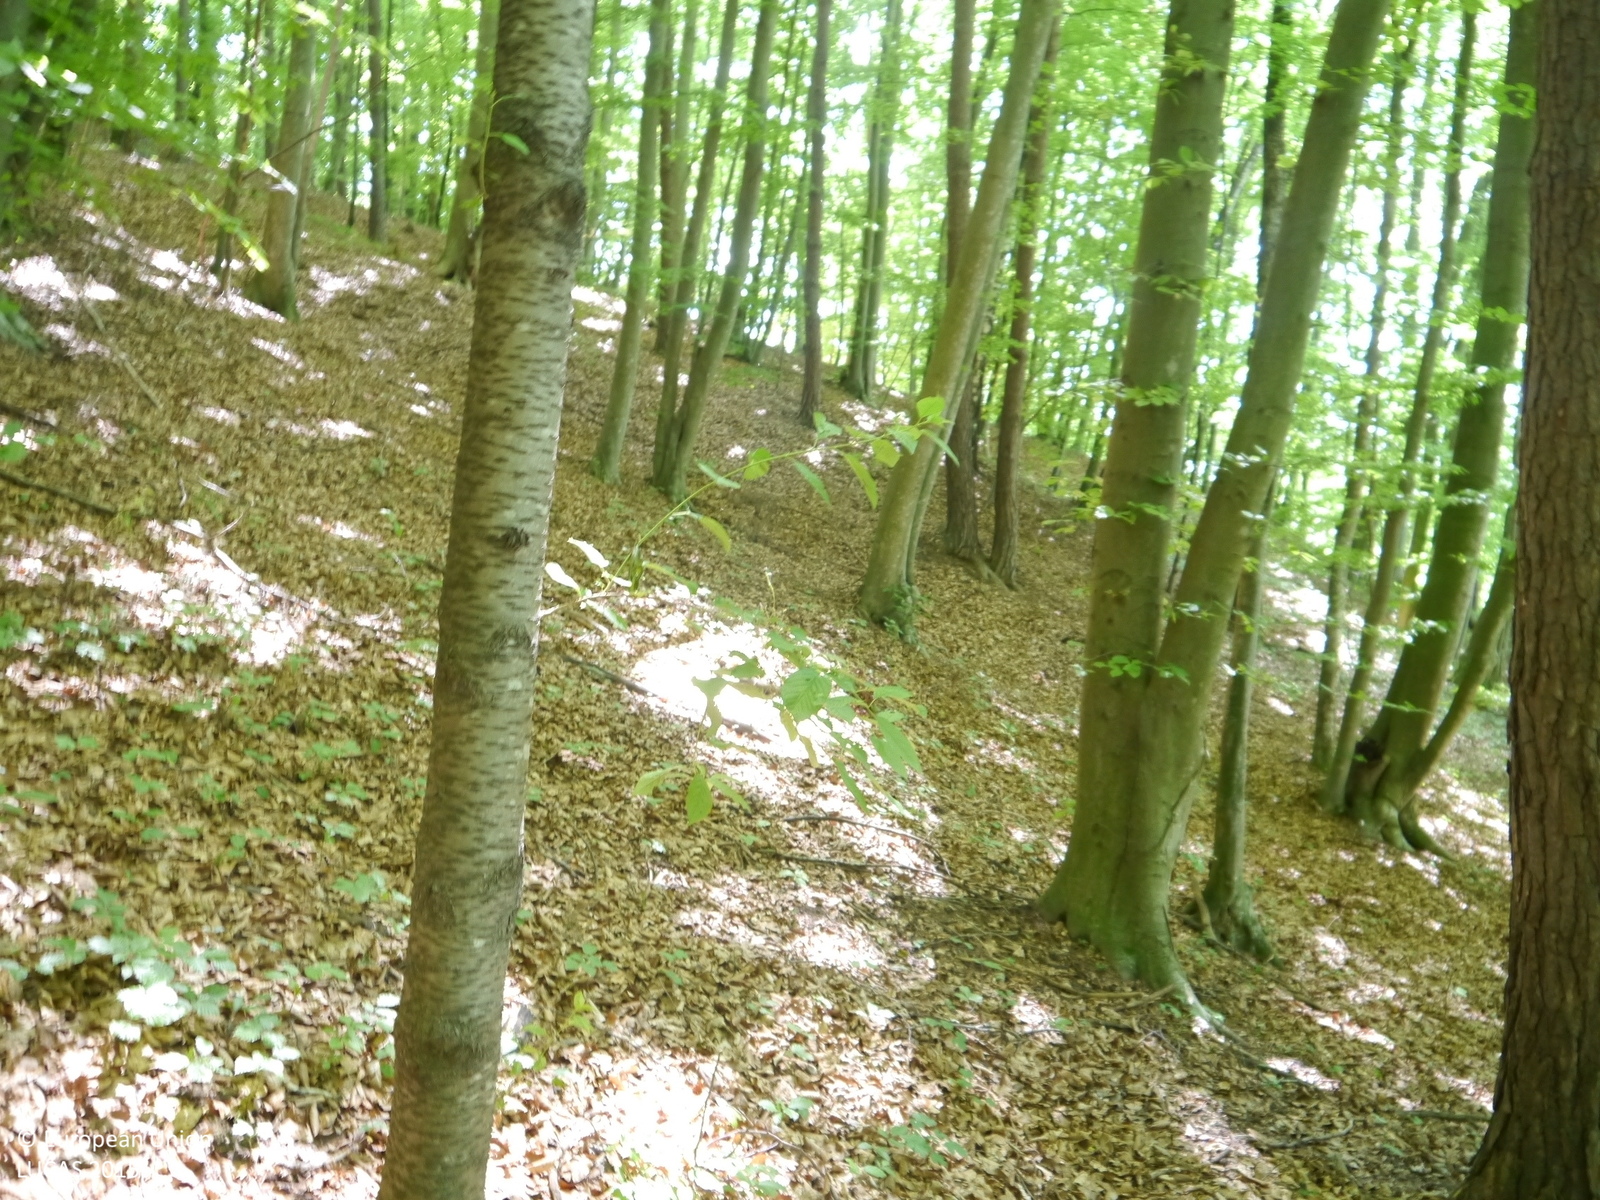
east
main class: Woodland
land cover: Broadleaved woodland
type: mountainous beech forest
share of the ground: > 75 %
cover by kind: broadleaved forest trees 95 %, coniferous forest trees 5 %
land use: Forestry
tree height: > 5 m
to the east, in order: Broadleaved woodland; Paved roads, cycling and walking lanes; Grassland without tree/shrub cover; Broadleaved woodland; Grass margins; Maize
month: June
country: AT
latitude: 46.9427
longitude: 15.6358
